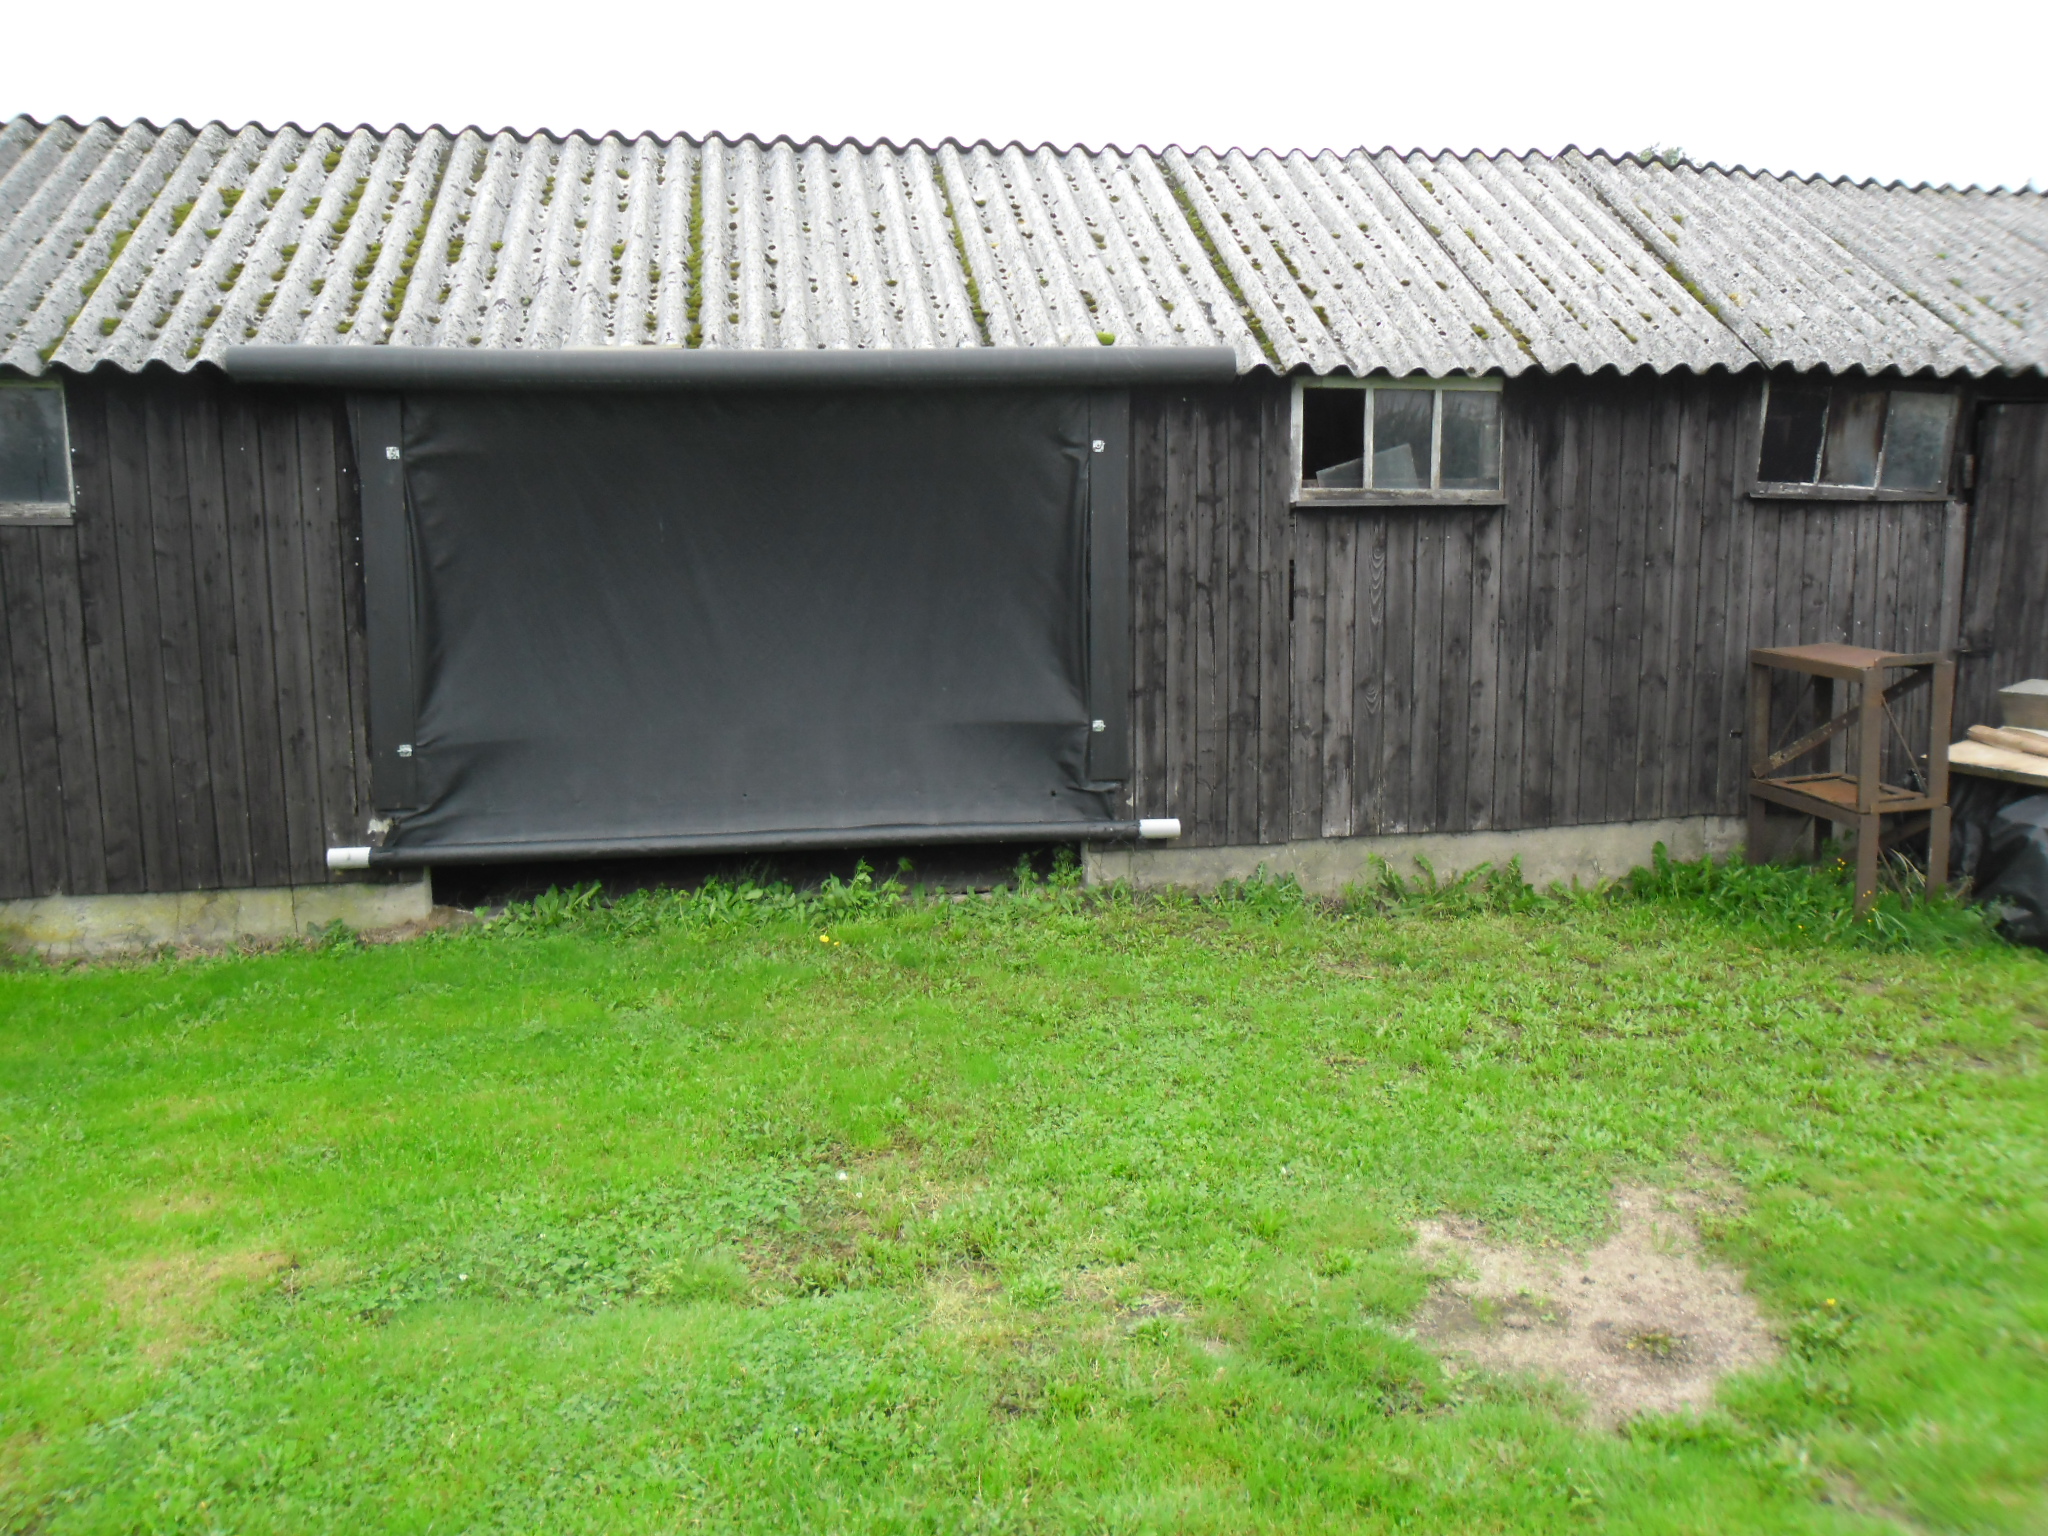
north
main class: Grassland
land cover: Grassland without tree/shrub cover
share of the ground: > 75 %
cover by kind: herbaceous plants 100 %
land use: Residential
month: September
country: NL
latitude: 52.1193
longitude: 5.6902
